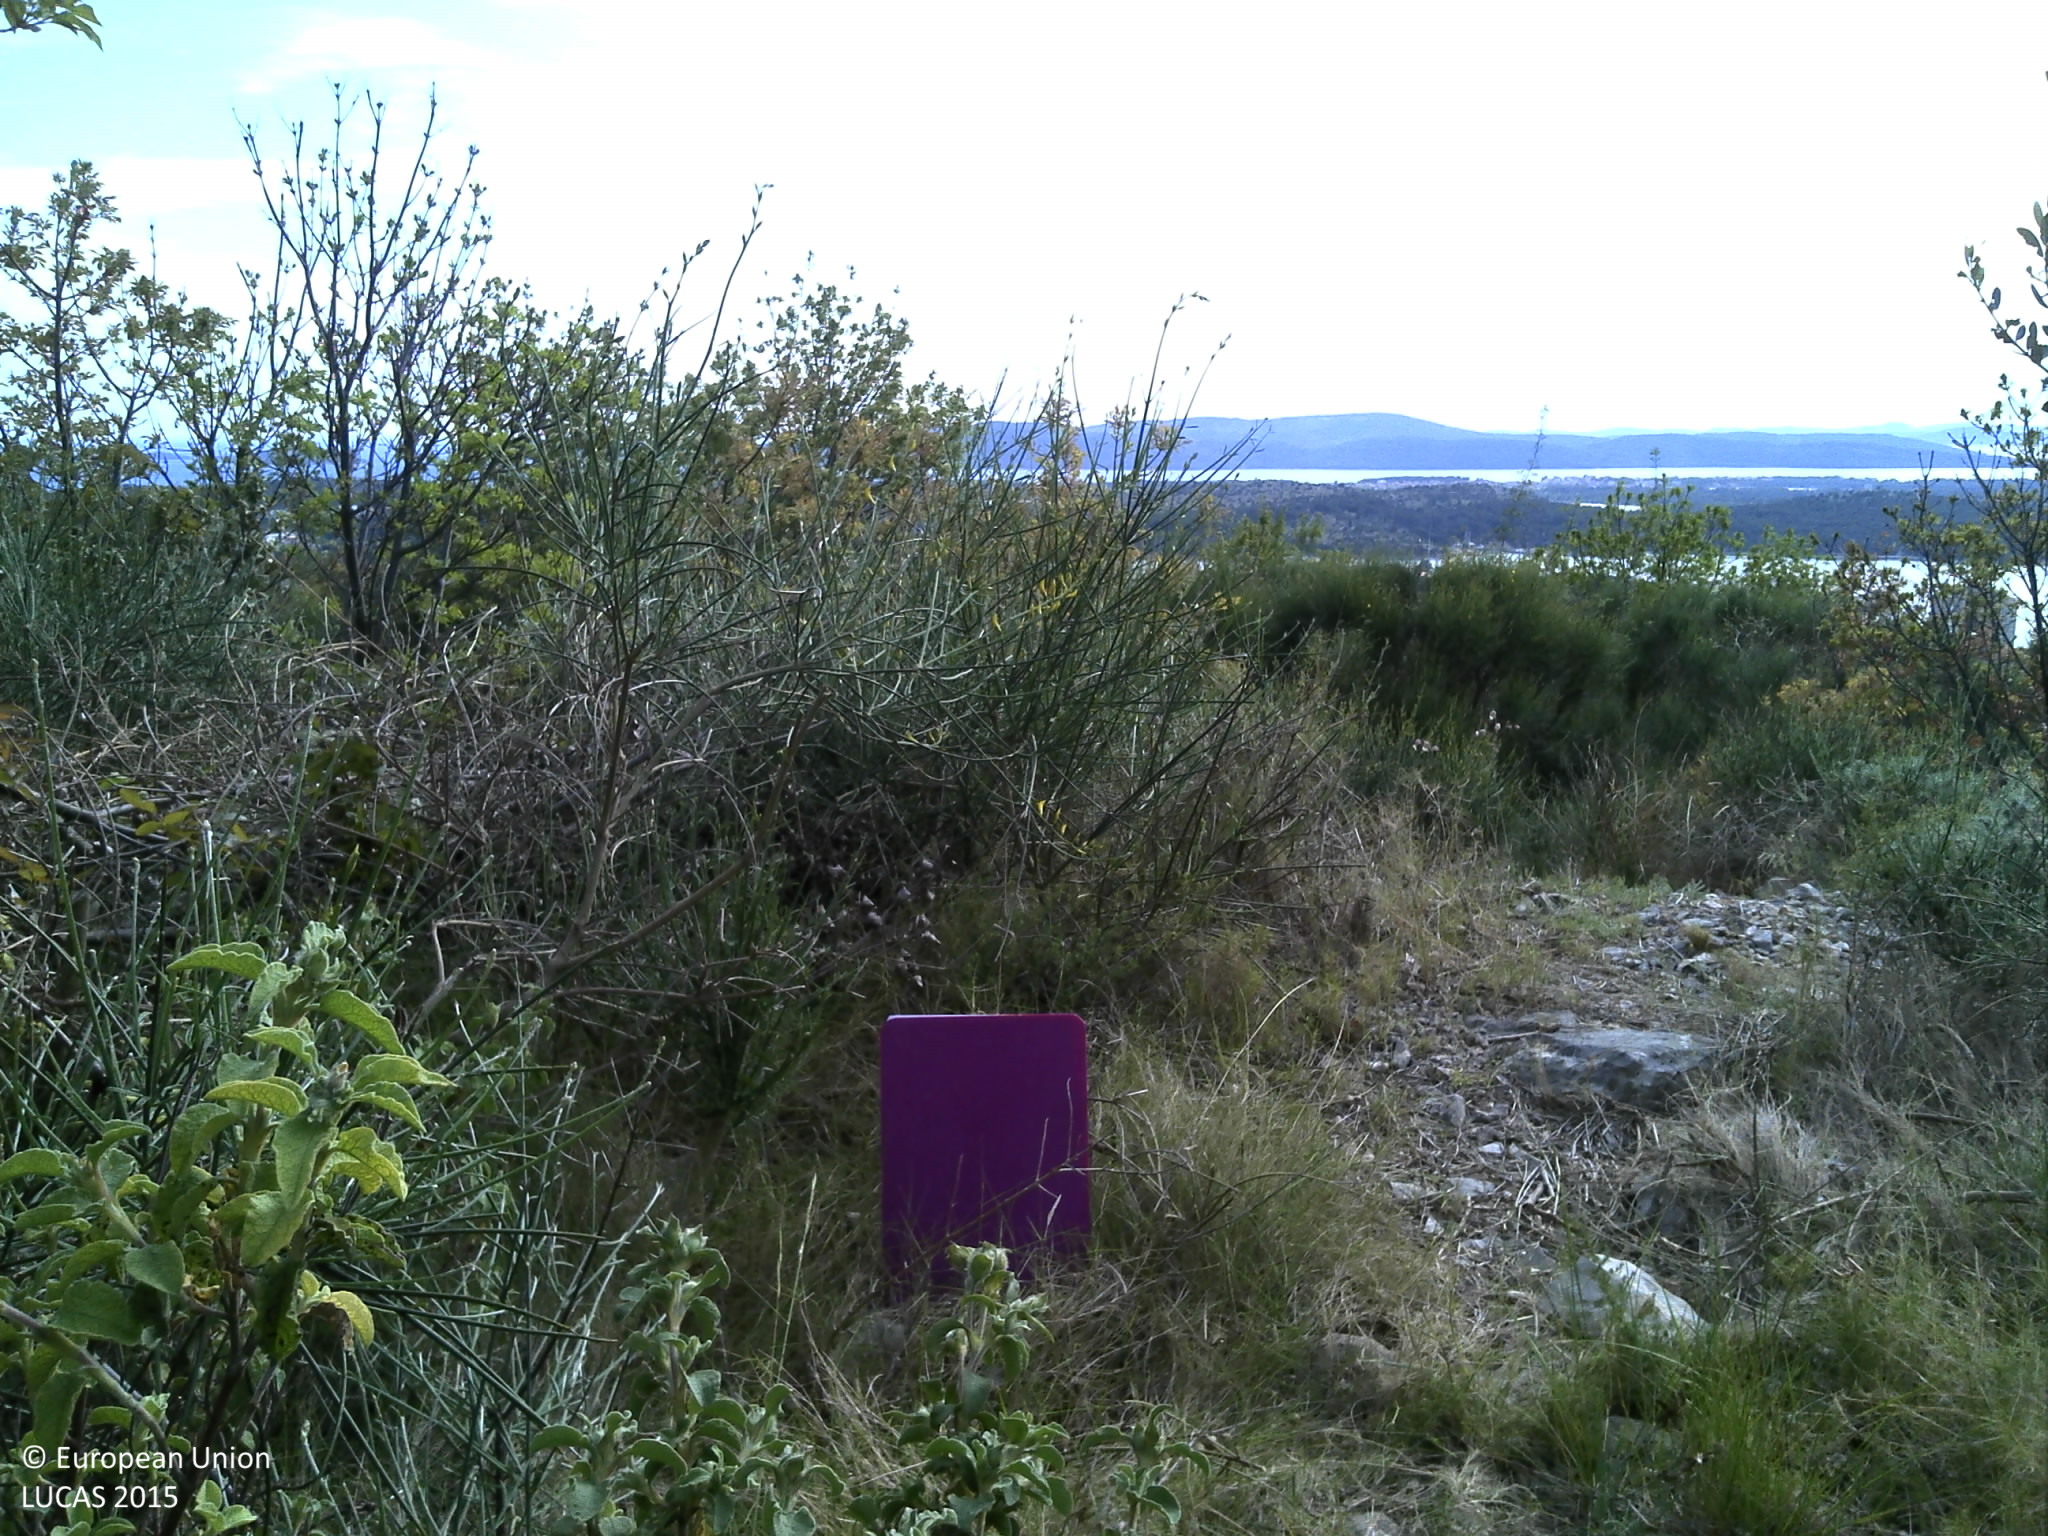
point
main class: Shrubland
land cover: Shrubland with sparse tree cover
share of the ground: 50 - 75 %
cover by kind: shrubs 65 %, herbaceous plants 20 %, unconsolidated bare surface 10 %, broadleaved forest trees 5 %
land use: Semi-natural and natural areas not in use
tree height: < 5 m
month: April
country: HR
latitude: 43.7298
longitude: 15.9129
